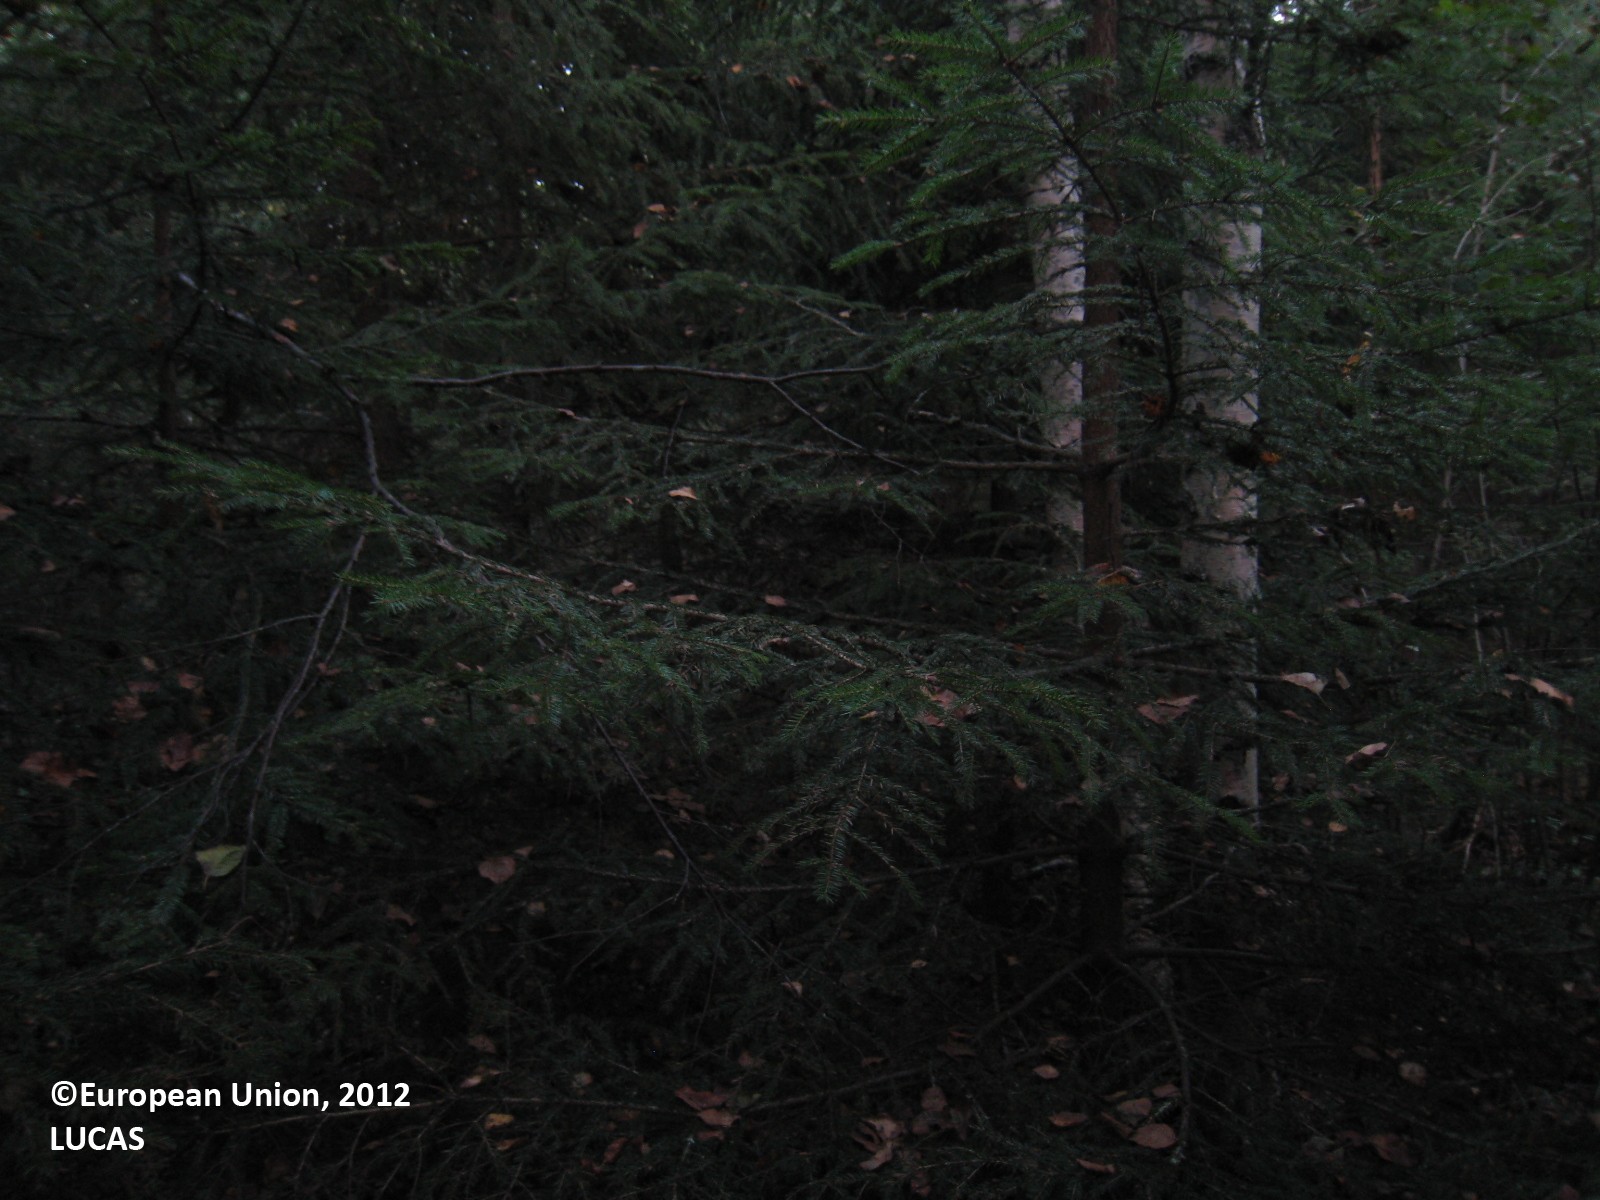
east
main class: Woodland
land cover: Spruce dominated mixed woodland
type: boreal forest
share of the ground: > 75 %
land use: Forestry
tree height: > 5 m
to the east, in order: Spruce dominated mixed woodland; Ditches and canals; Spruce dominated mixed woodland; Ditches and canals; Spruce dominated mixed woodland; Broadleaved woodland; Grassland with sparse tree/shrub cover; Broadleaved woodland; Tracks; Ditches and canals; Broadleaved woodland; Spruce dominated mixed woodland; Broadleaved woodland
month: September
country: FI
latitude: 62.7972
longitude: 26.5475
